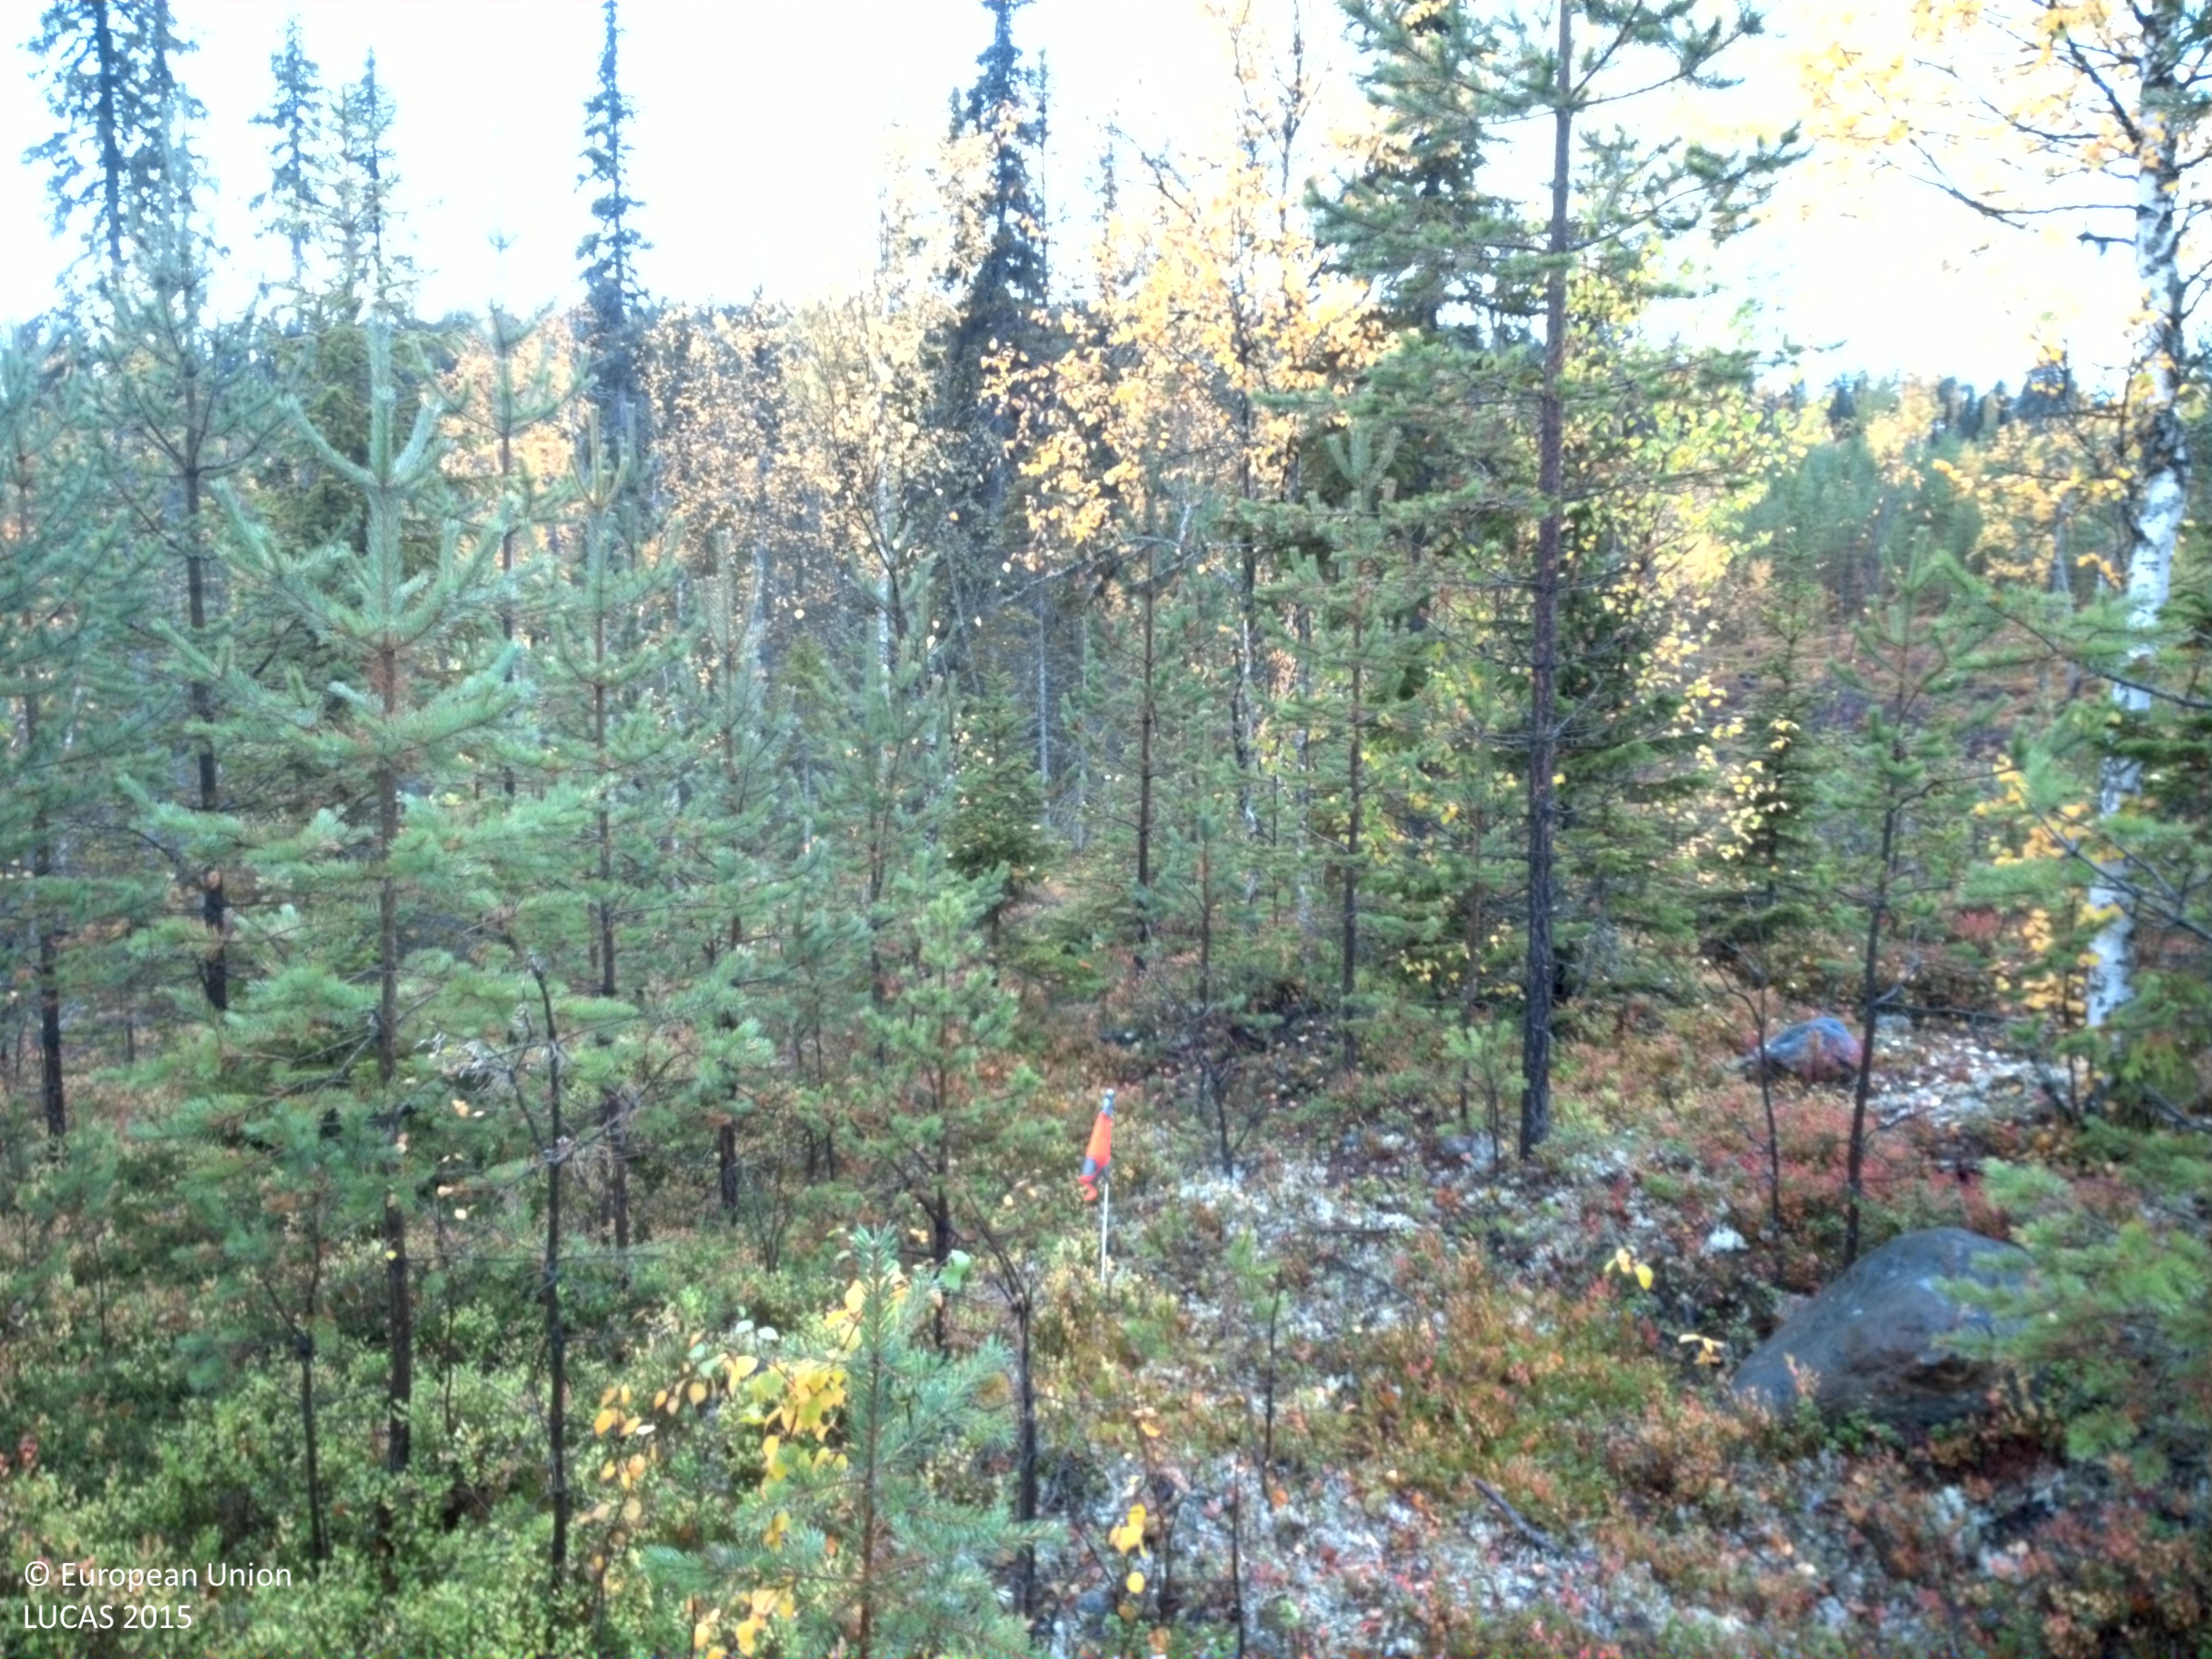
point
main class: Woodland
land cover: Pine dominated coniferous woodland
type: boreal forest
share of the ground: 25 - 50 %
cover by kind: shrubs 40 %, lichens and mosses 30 %, coniferous forest trees 20 %, broadleaved forest trees 5 %, unconsolidated bare surface 5 %
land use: Forestry
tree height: > 5 m
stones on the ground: < 10 %
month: September
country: SE
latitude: 65.0934
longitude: 17.4751
